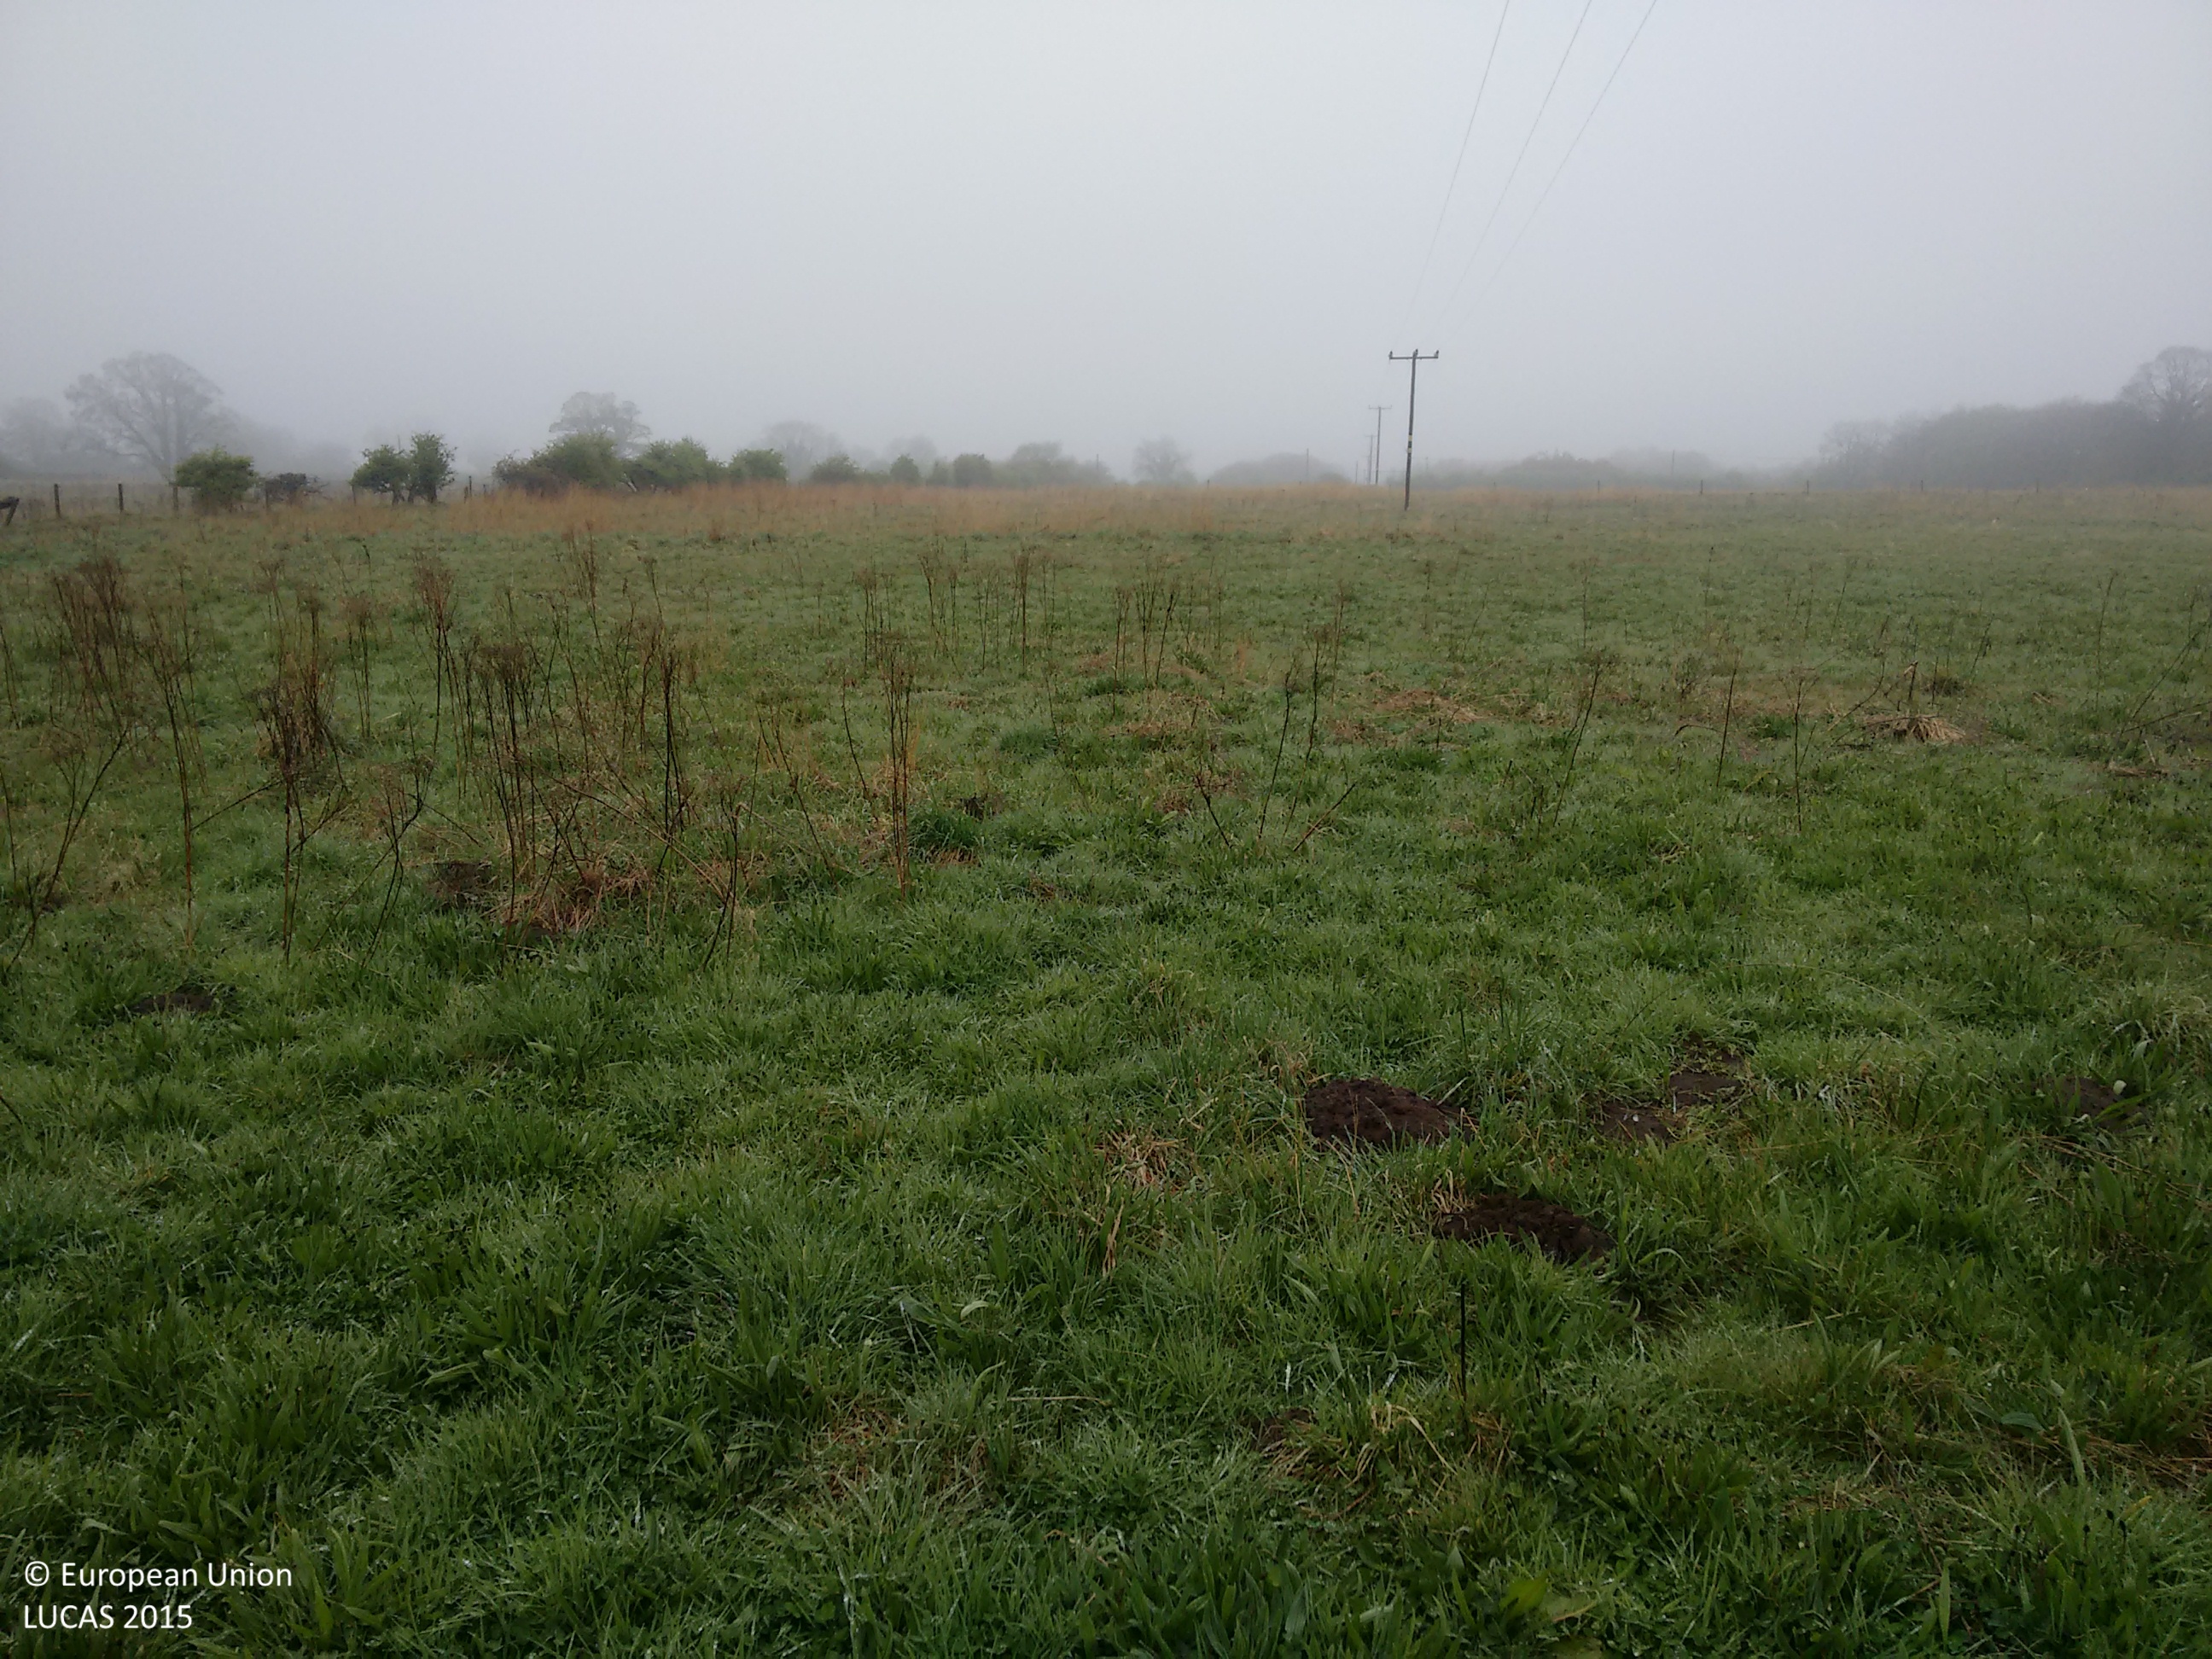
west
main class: Grassland
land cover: Grassland without tree/shrub cover
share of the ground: > 75 %
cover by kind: herbaceous plants 100 %
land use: Agriculture (excluding fallow land and kitchen gardens)
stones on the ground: < 10 %
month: May
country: GB
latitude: 55.1641
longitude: -1.6491
